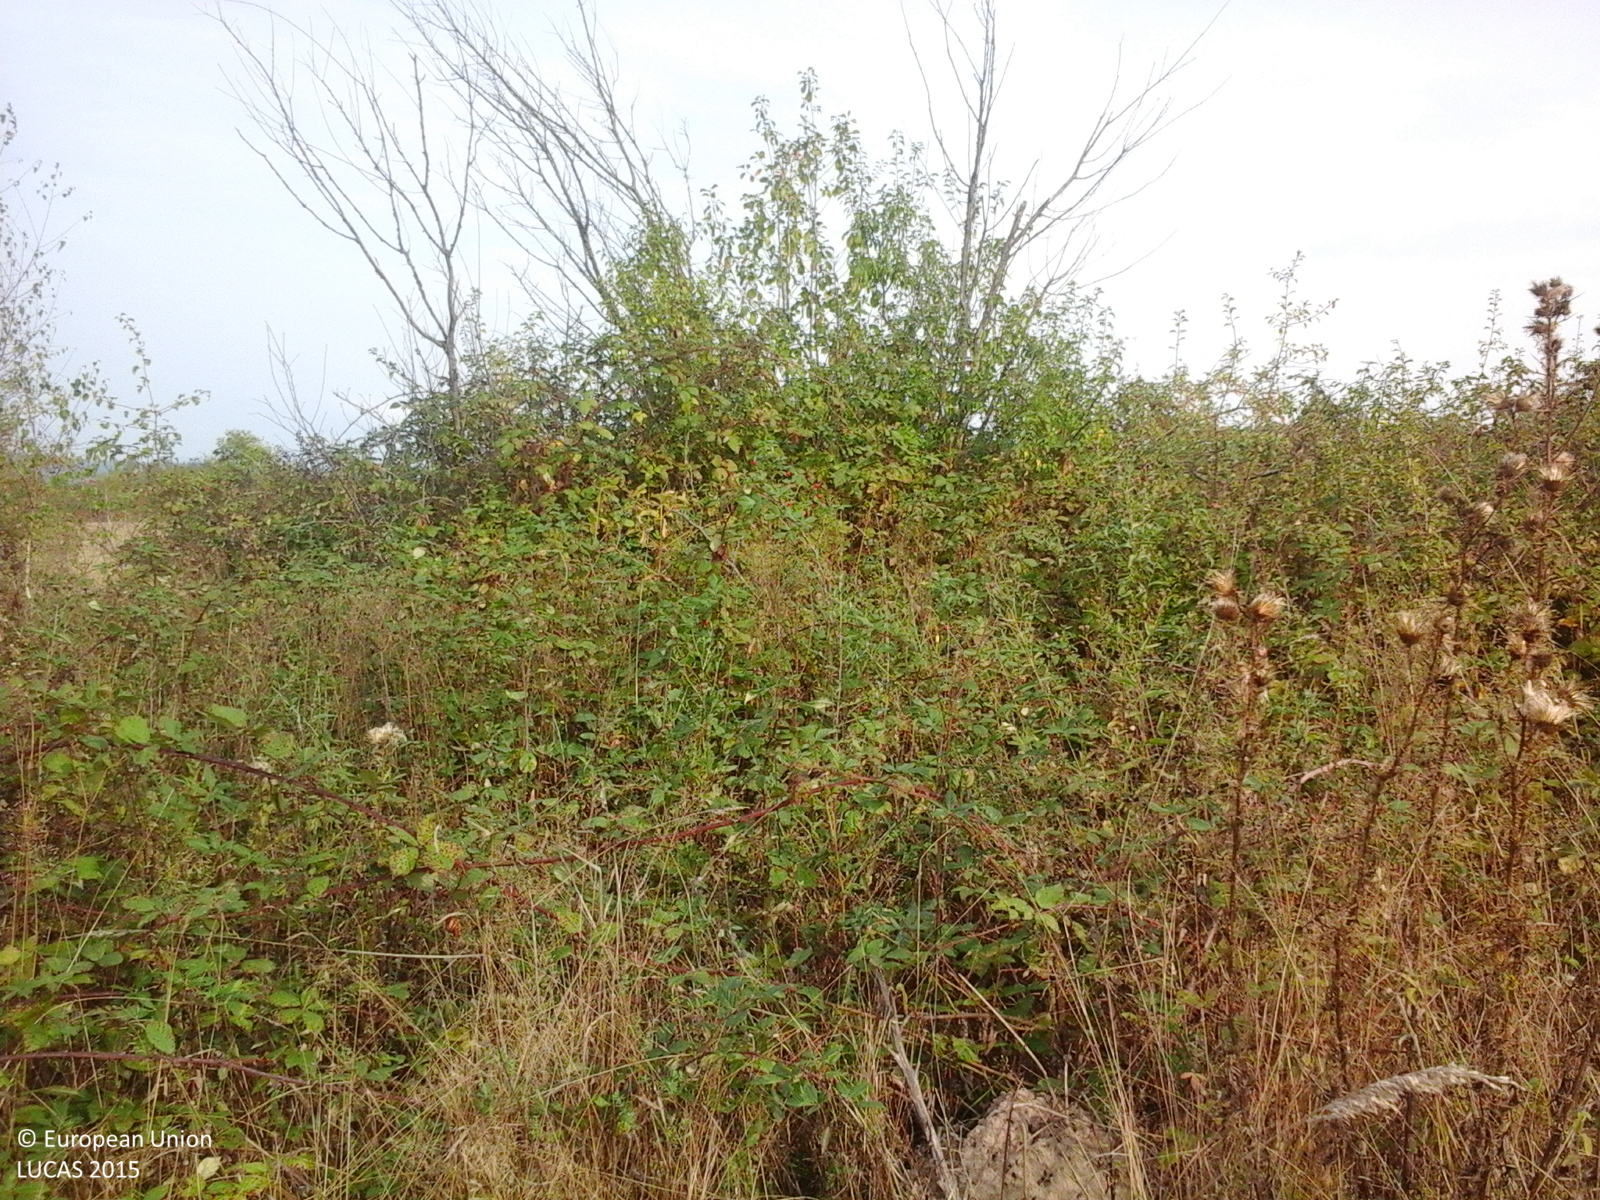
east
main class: Cropland
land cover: Other fruit trees and berries
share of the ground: 50 - 75 %
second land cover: Spontaneously vegetated surfaces
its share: > 75 %
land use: Agriculture (excluding fallow land and kitchen gardens)
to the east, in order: Other fruit trees and berries; Spontaneously vegetated surfaces; Tracks; Spontaneously vegetated surfaces; Other fruit trees and berries; Abandoned hedges; Other fruit trees and berries
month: September
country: RO
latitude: 45.4018
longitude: 21.9827
